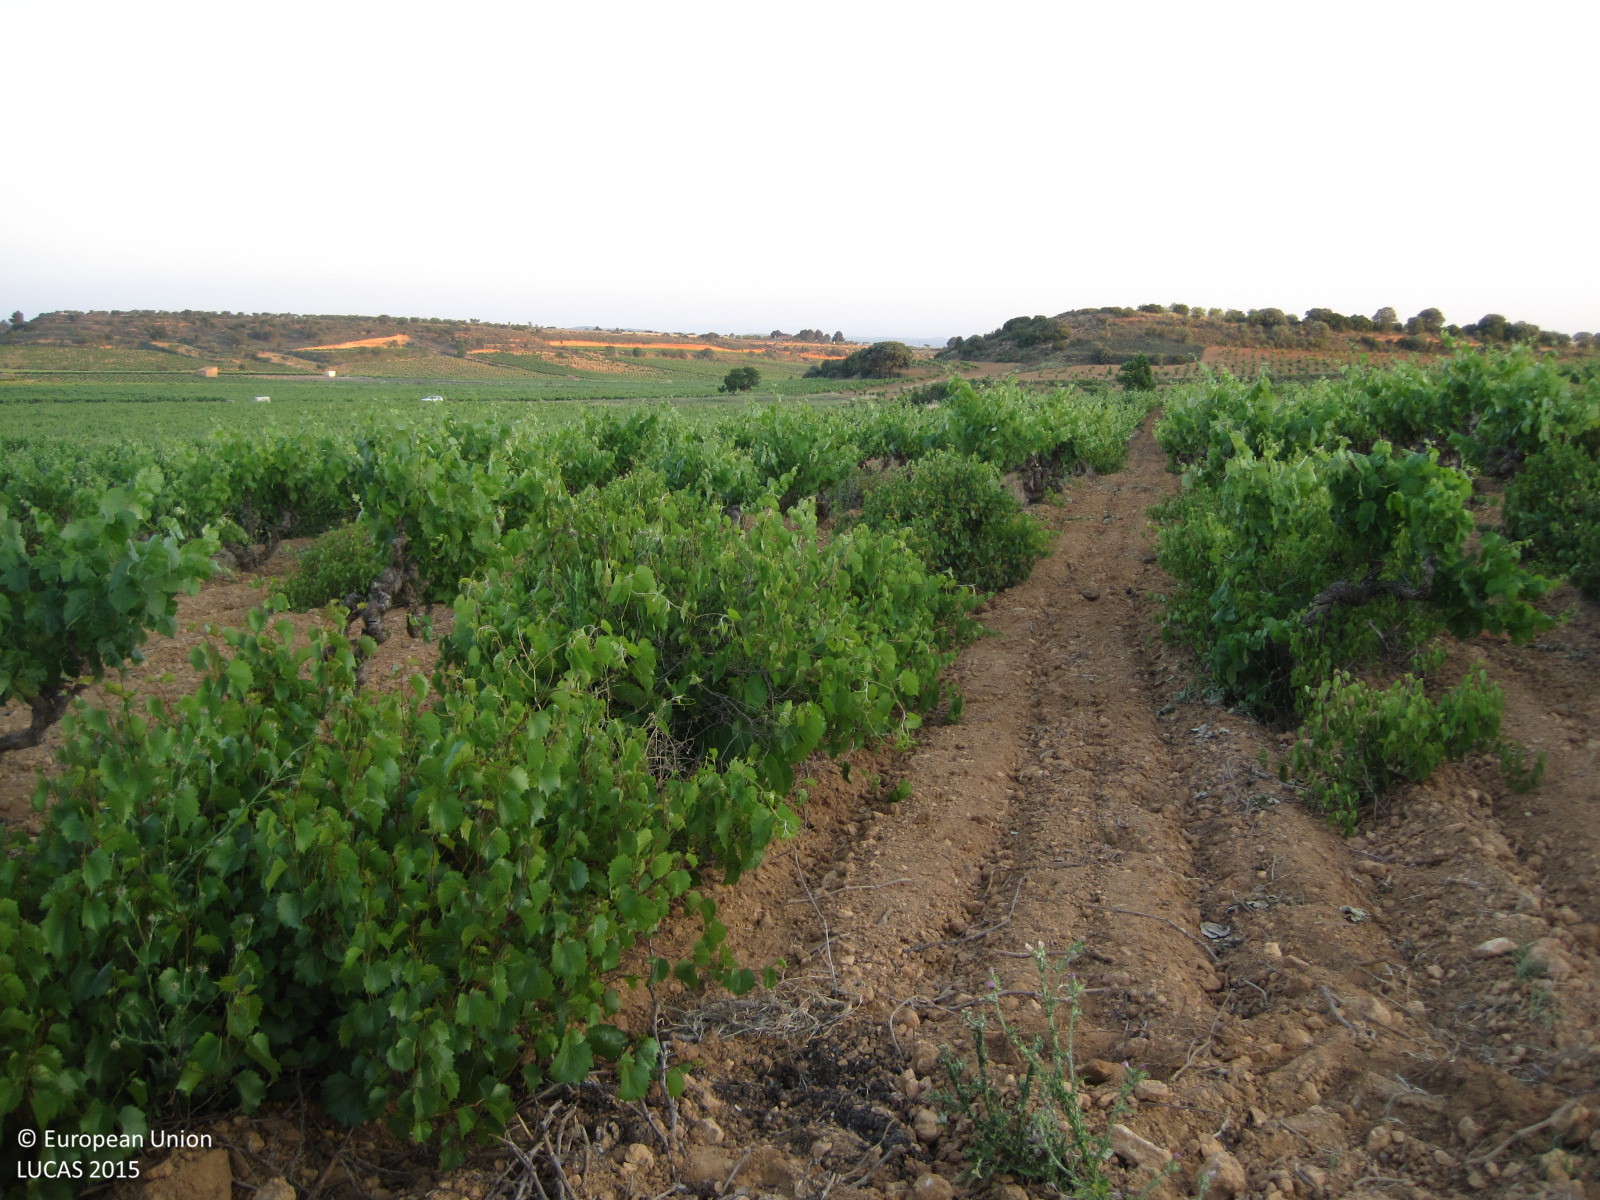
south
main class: Cropland
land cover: Vineyards
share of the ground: 25 - 50 %
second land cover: Other bare soil
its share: > 75 %
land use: Agriculture (excluding fallow land and kitchen gardens)
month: May
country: ES
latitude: 39.5425
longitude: -1.1144
